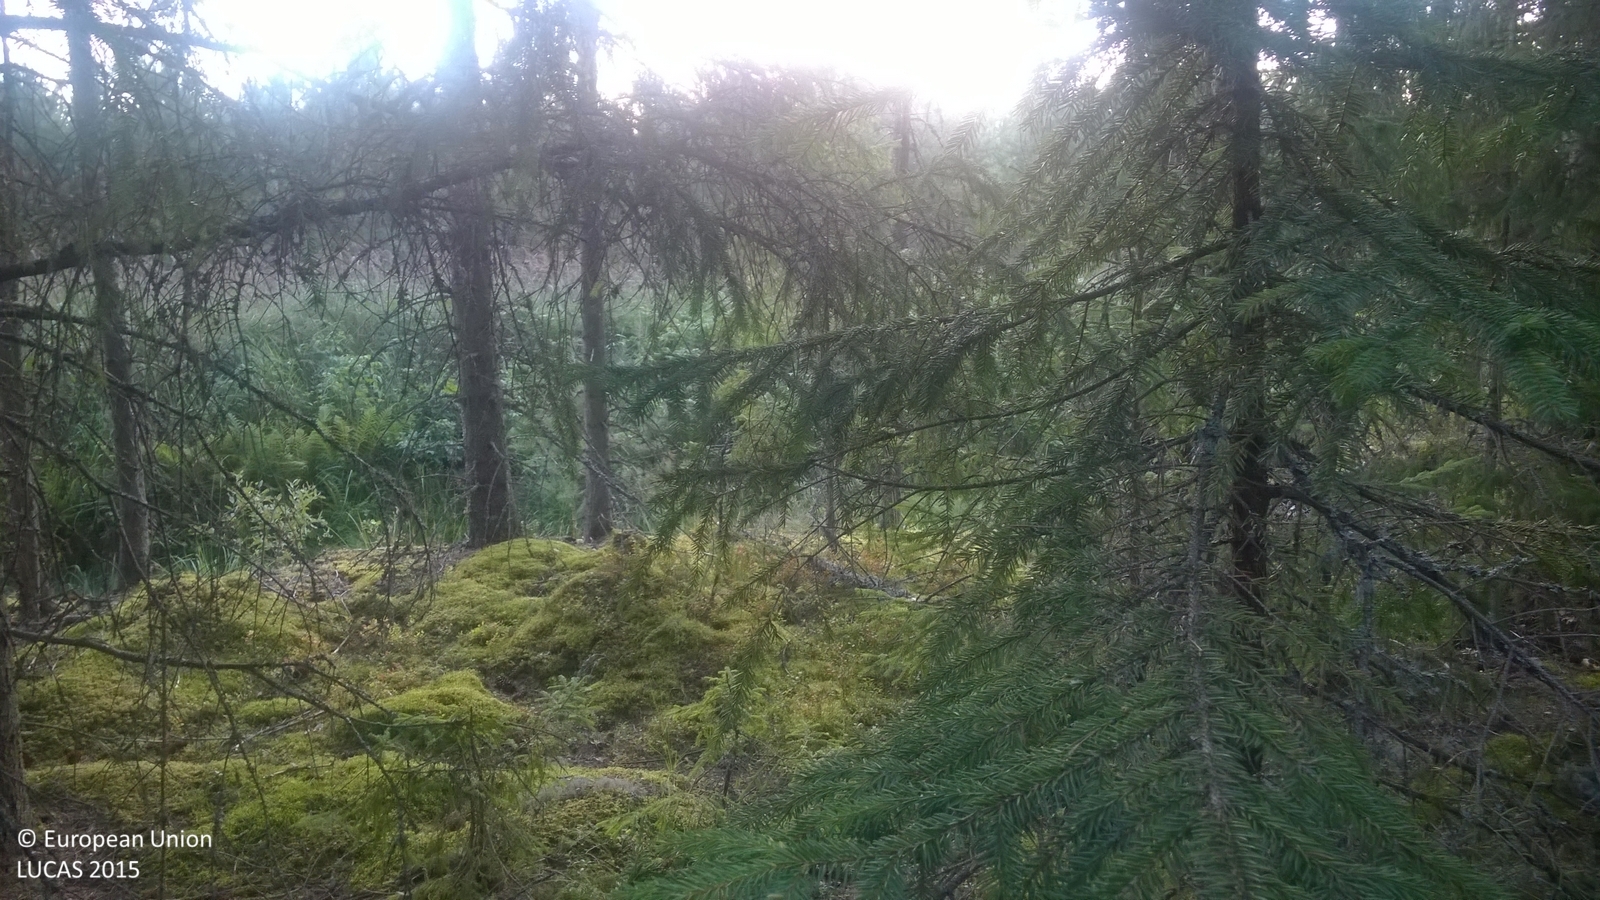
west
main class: Woodland
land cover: Spruce dominated coniferous woodland
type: hemiboreal forest and nemoral coniferous forest and mixed broadleaved-coniferous forest
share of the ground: > 75 %
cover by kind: coniferous forest trees 85 %, lichens and mosses 10 %, unconsolidated bare surface 5 %
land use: Forestry
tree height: > 5 m
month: August
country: LV
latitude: 57.6523
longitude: 26.0308
